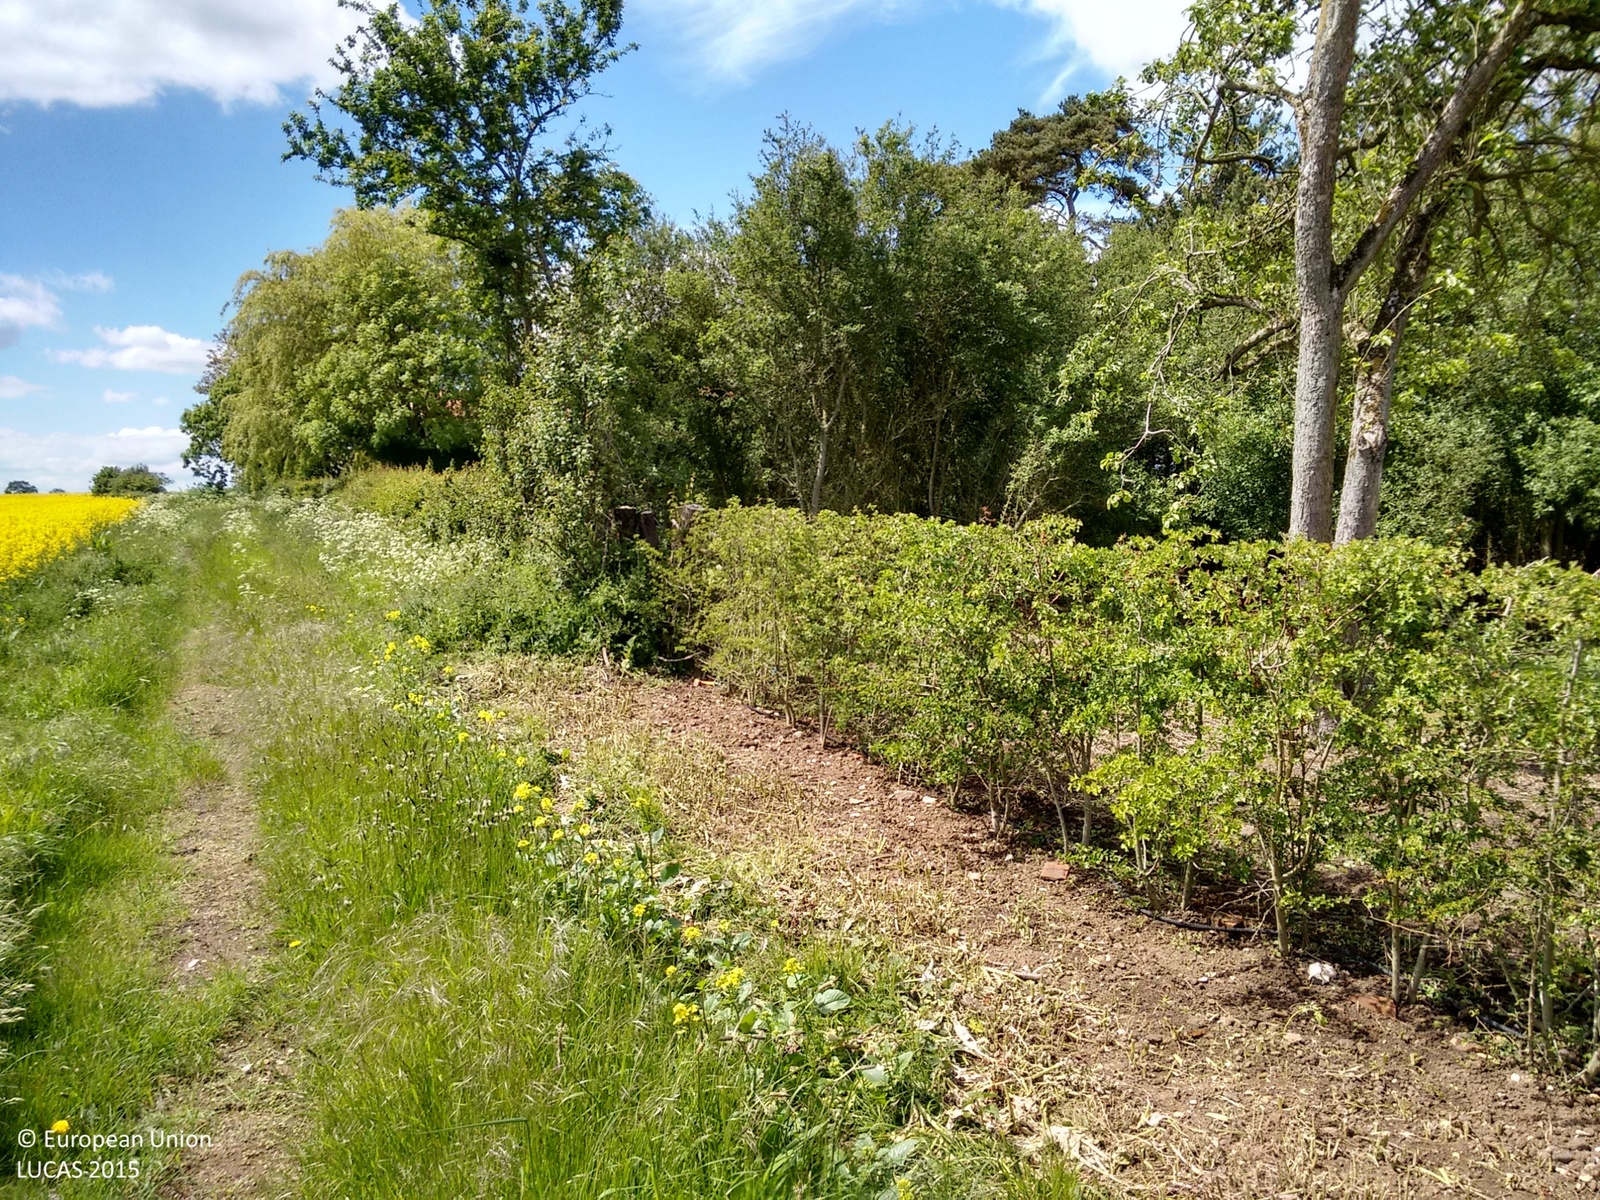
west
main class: Cropland
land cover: Rape and turnip rape
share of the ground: > 75 %
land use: Agriculture (excluding fallow land and kitchen gardens)
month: June
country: GB
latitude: 53.5051
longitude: -0.0892
